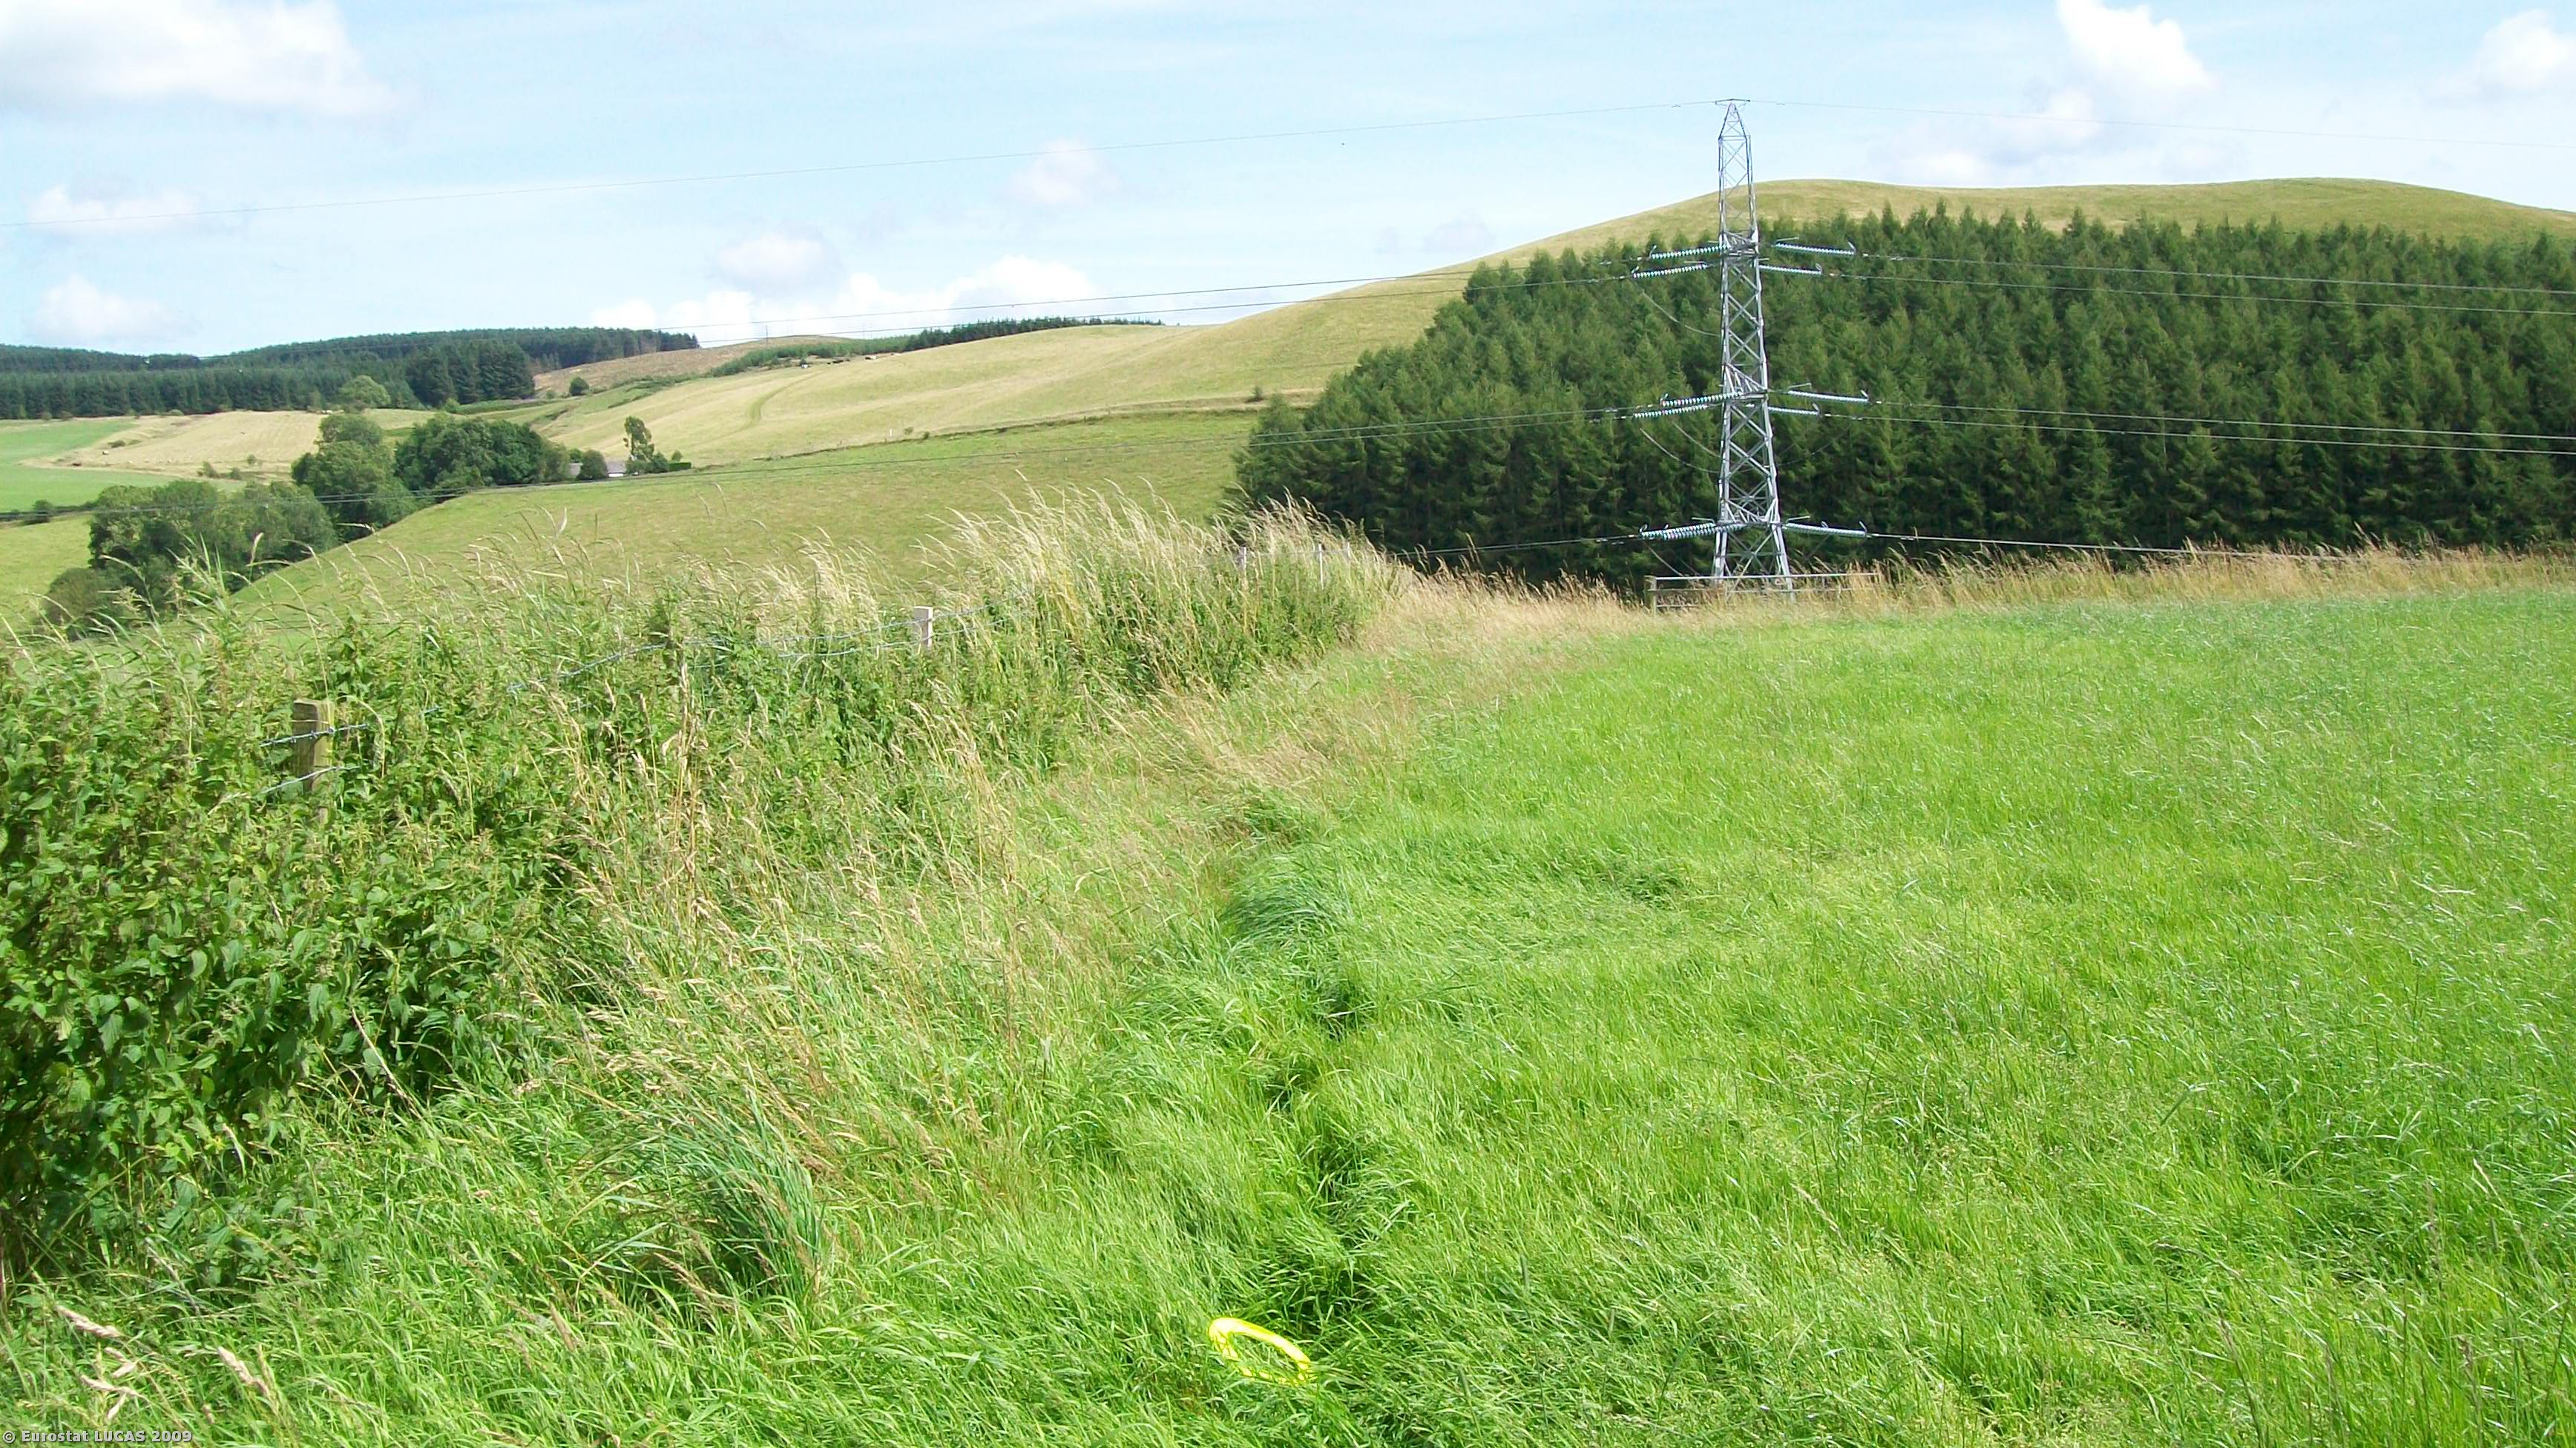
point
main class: Grassland
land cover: Grassland without tree/shrub cover
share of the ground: > 75 %
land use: Agriculture (excluding fallow land and kitchen gardens)
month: August
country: GB
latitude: 55.2291
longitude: -3.3630
